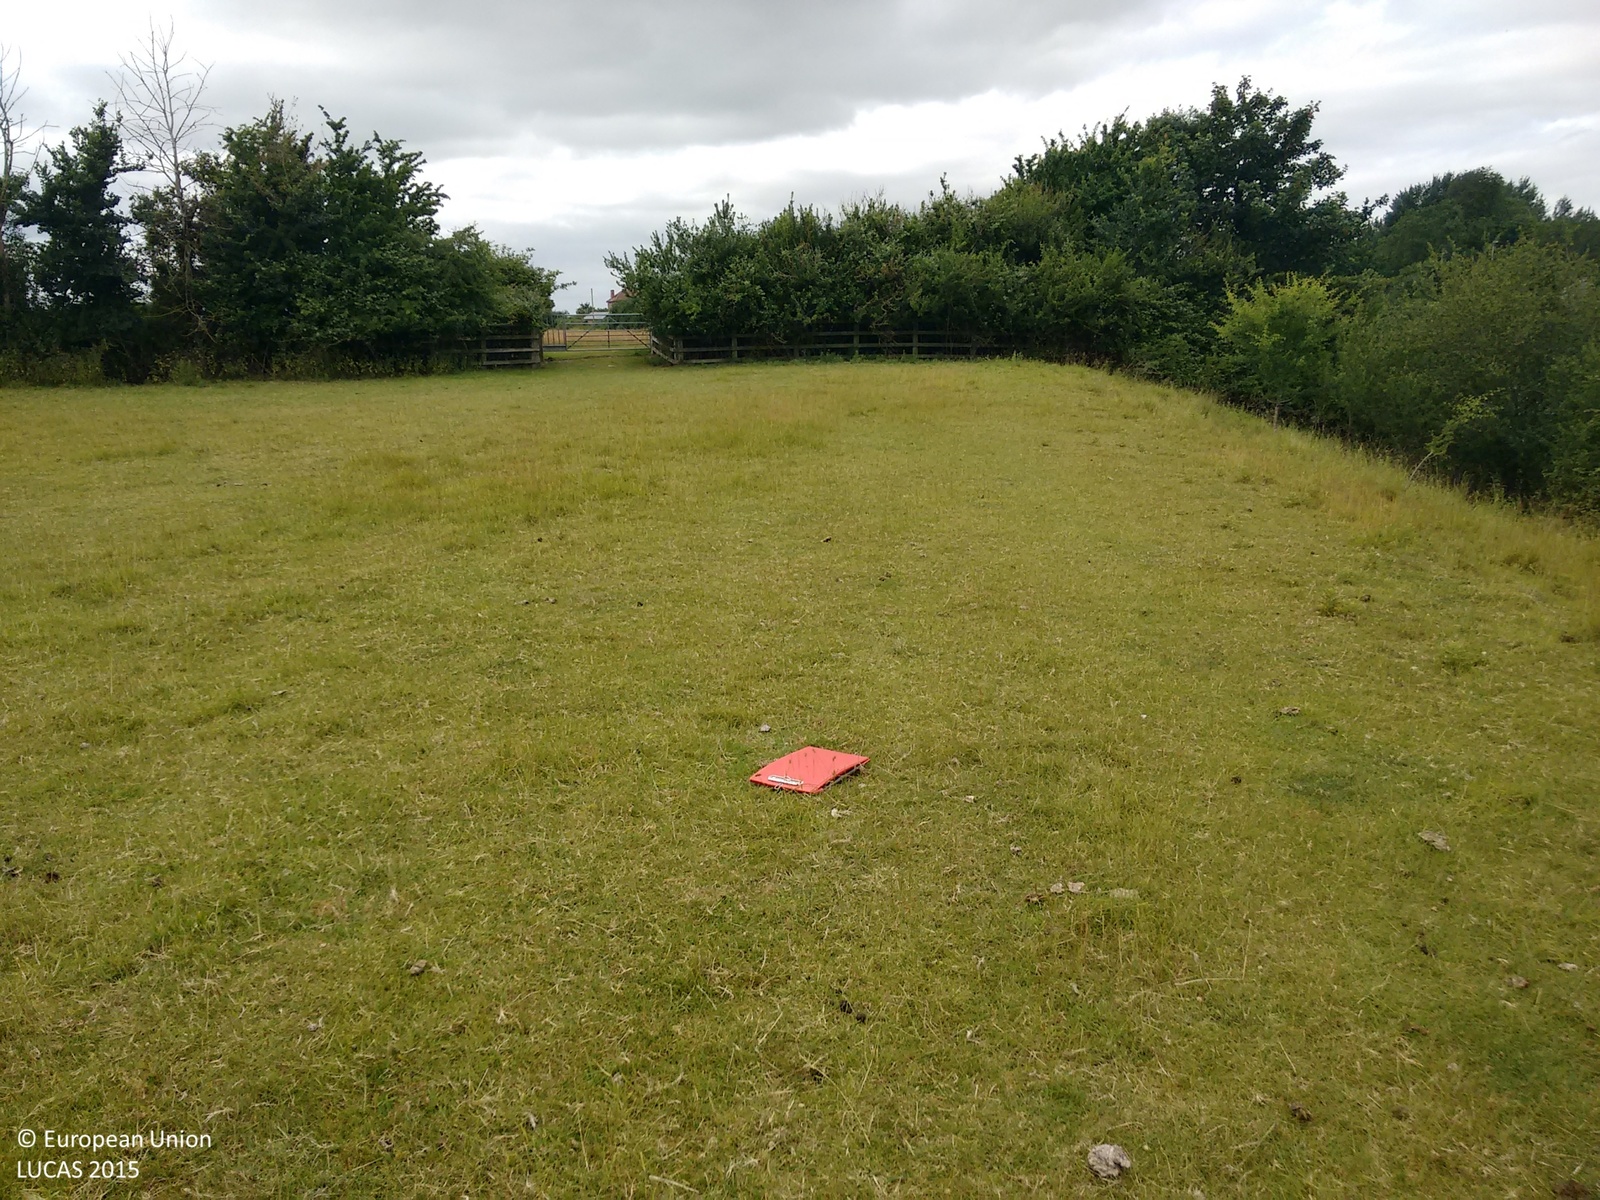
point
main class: Grassland
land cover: Grassland without tree/shrub cover
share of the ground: > 75 %
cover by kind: herbaceous plants 100 %
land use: Agriculture (excluding fallow land and kitchen gardens)
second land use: Amenities, museums, leisure
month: July
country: GB
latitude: 51.1535
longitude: -2.9558
